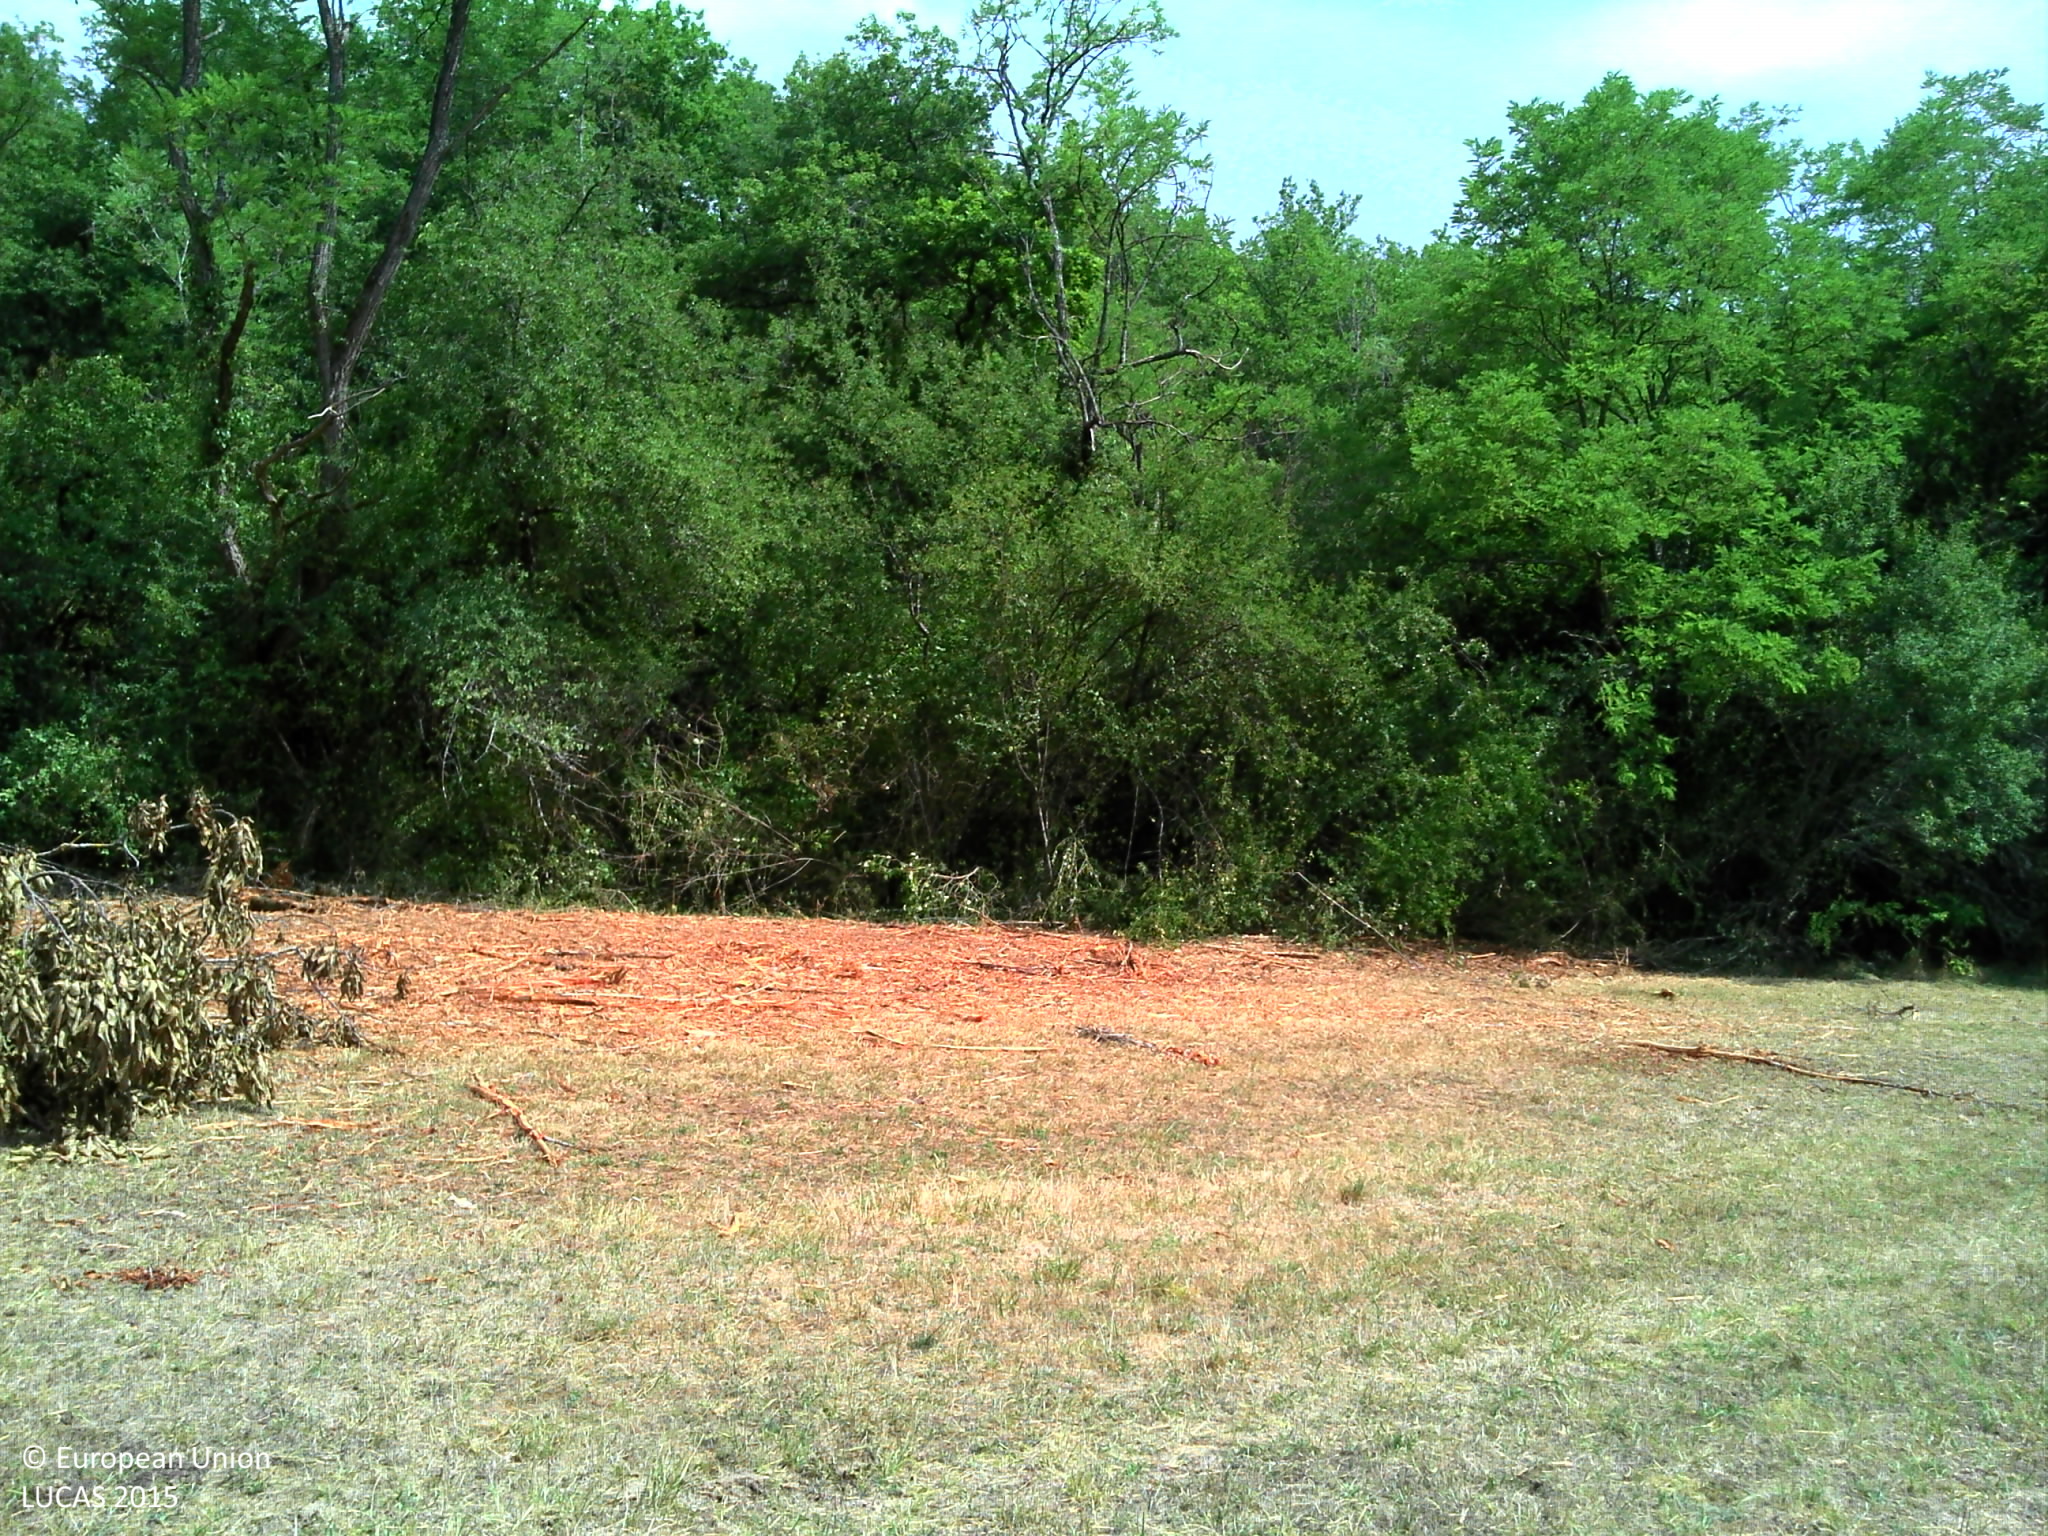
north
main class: Grassland
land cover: Grassland without tree/shrub cover
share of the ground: > 75 %
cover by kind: herbaceous plants 95 %, lichens and mosses 5 %
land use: Agriculture (excluding fallow land and kitchen gardens)
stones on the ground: < 10 %
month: July
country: FR
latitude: 45.0633
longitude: 1.1928
